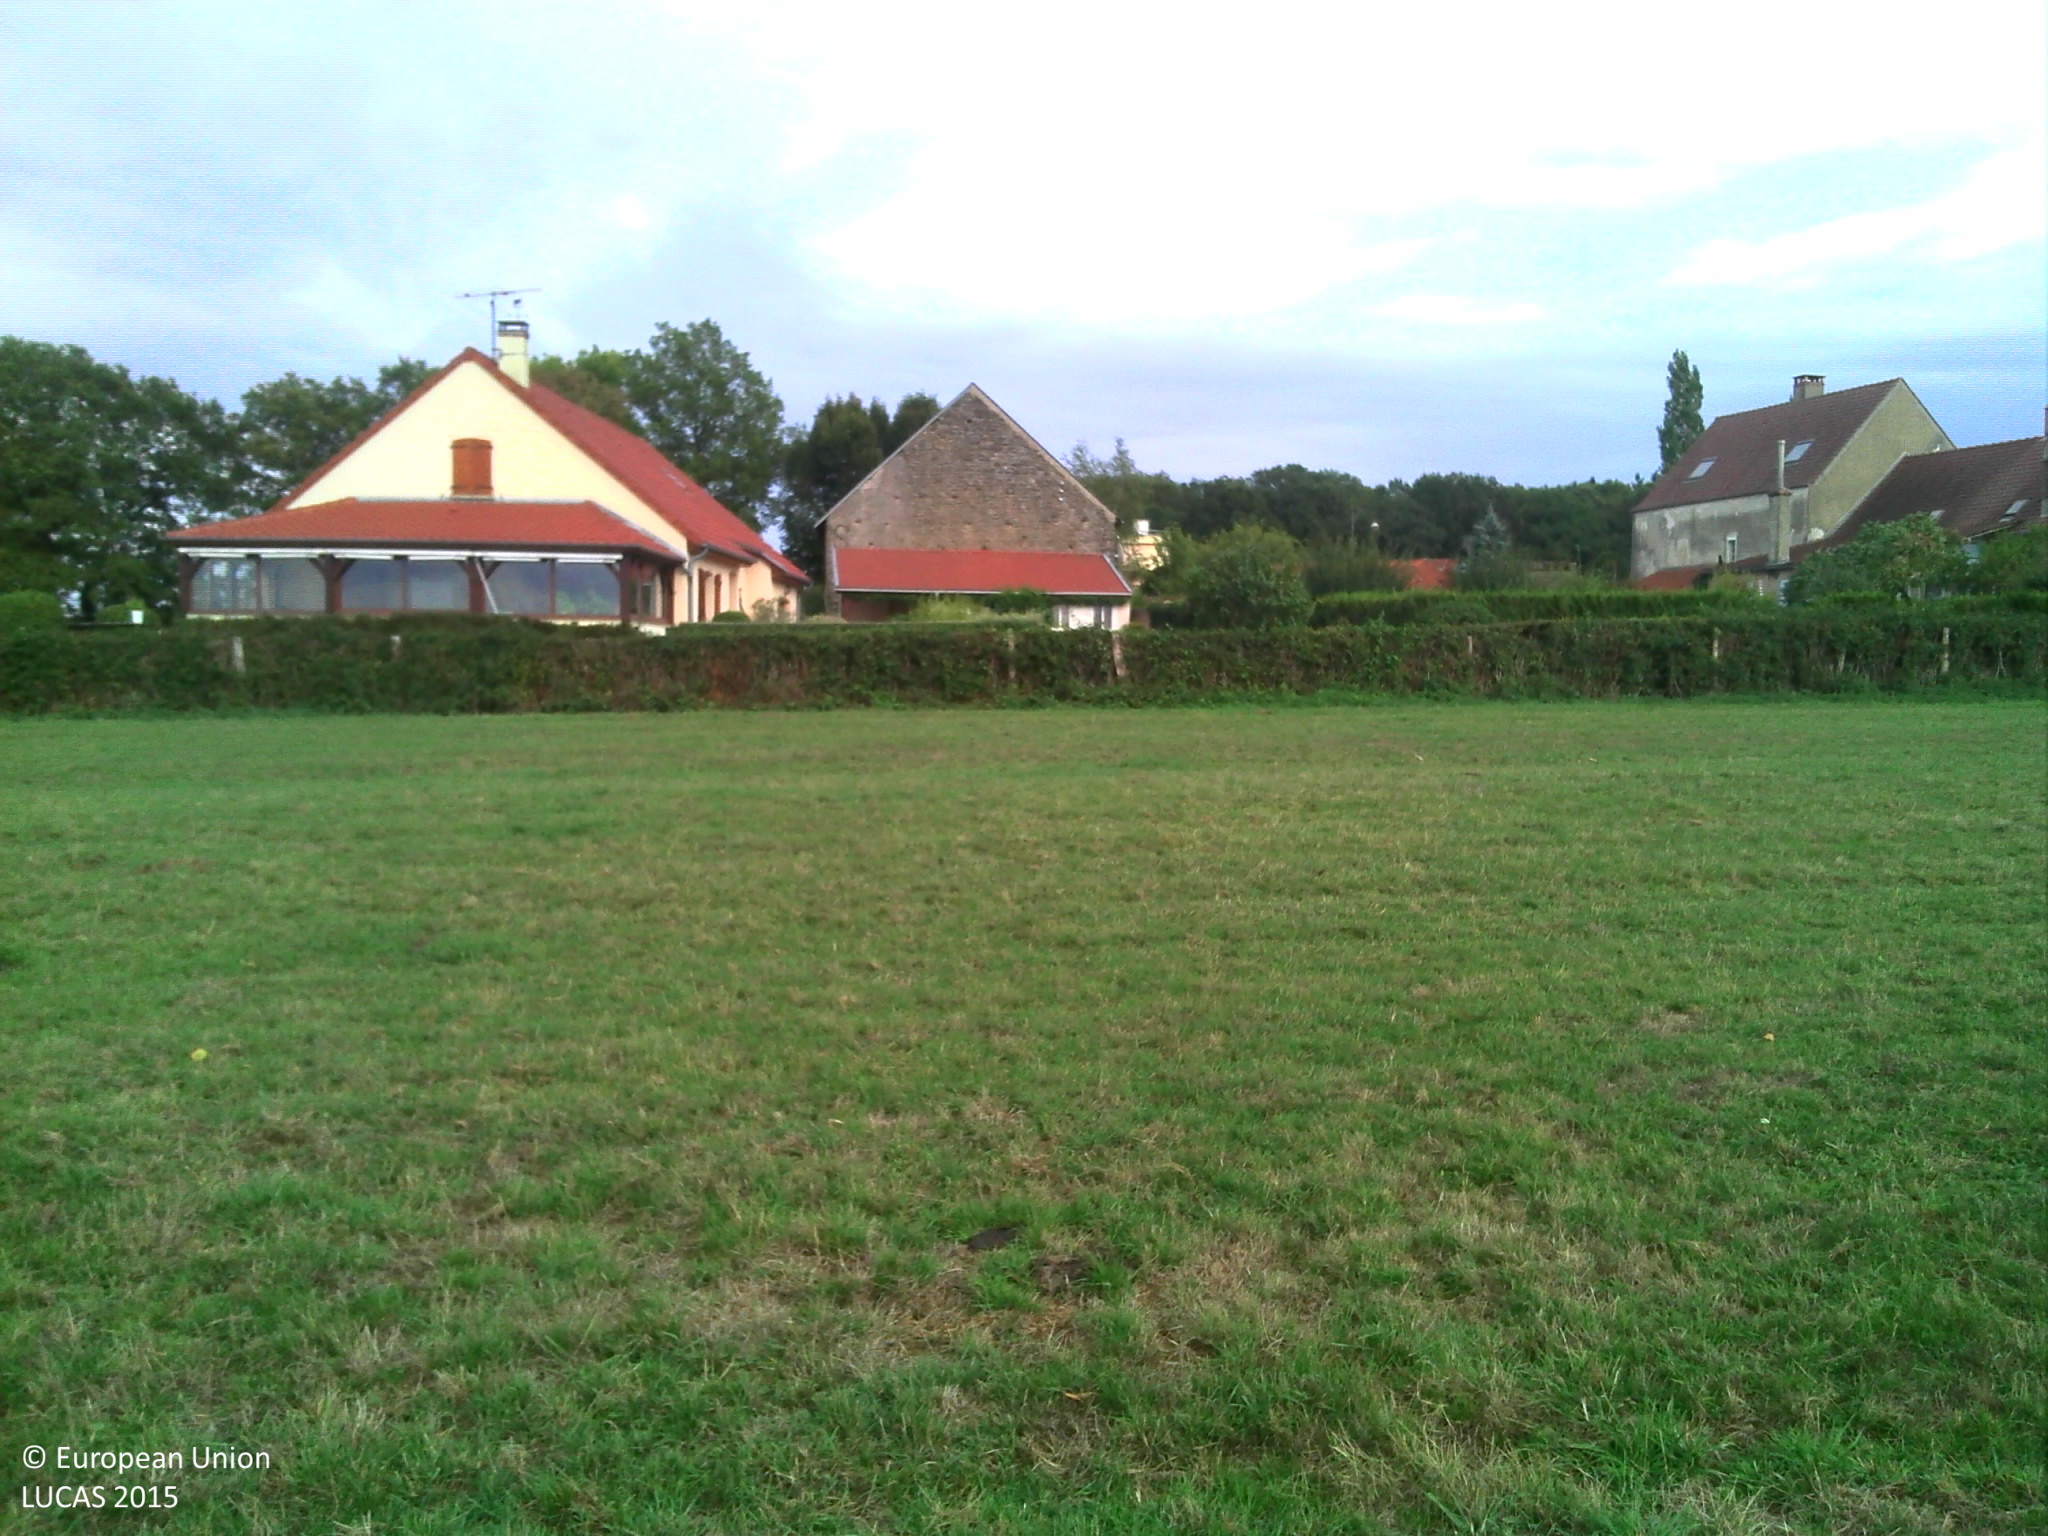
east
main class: Grassland
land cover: Grassland without tree/shrub cover
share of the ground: > 75 %
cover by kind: herbaceous plants 100 %
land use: Agriculture (excluding fallow land and kitchen gardens)
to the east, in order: Grassland without tree/shrub cover; Artificial constructions in urban areas; Ditches and canals; Grass margins; Fences; Grassland without tree/shrub cover
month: September
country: FR
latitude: 47.3913
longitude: 4.3155
